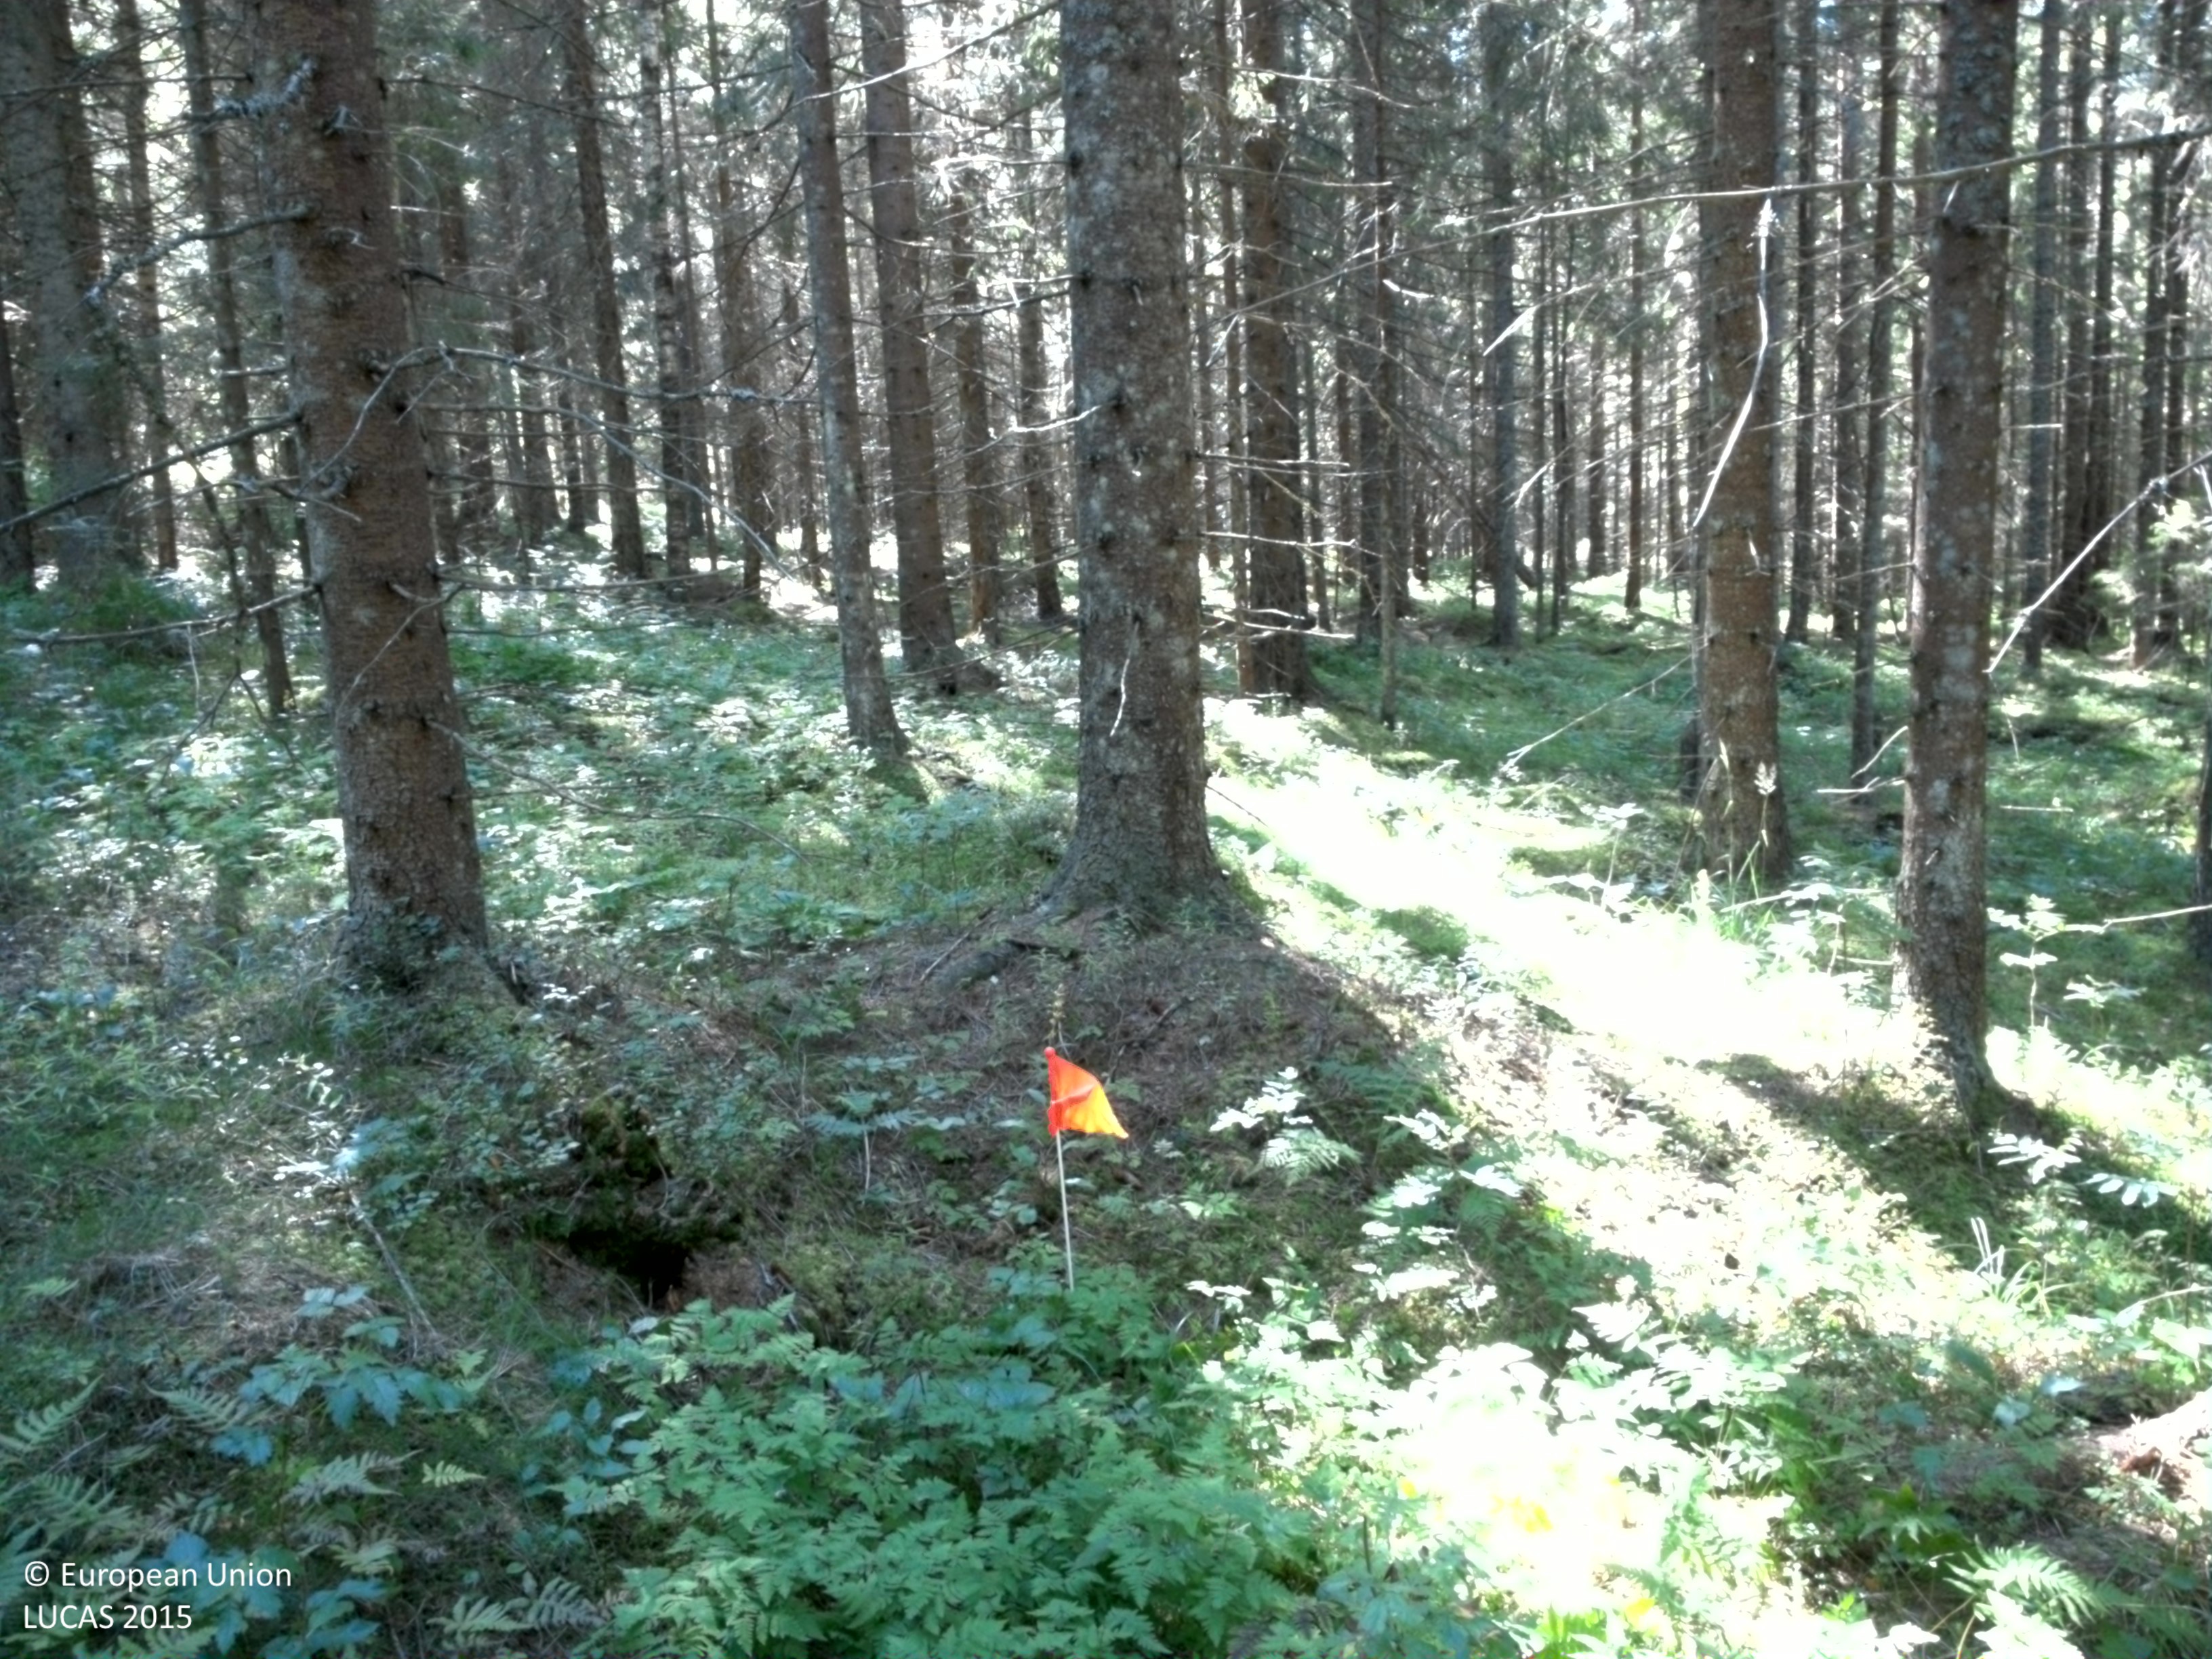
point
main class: Woodland
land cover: Spruce dominated coniferous woodland
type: boreal forest
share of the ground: > 75 %
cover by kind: coniferous forest trees 80 %, lichens and mosses 10 %, shrubs 5 %, herbaceous plants 5 %
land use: Forestry
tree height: > 5 m
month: August
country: SE
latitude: 59.9591
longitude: 14.0910
